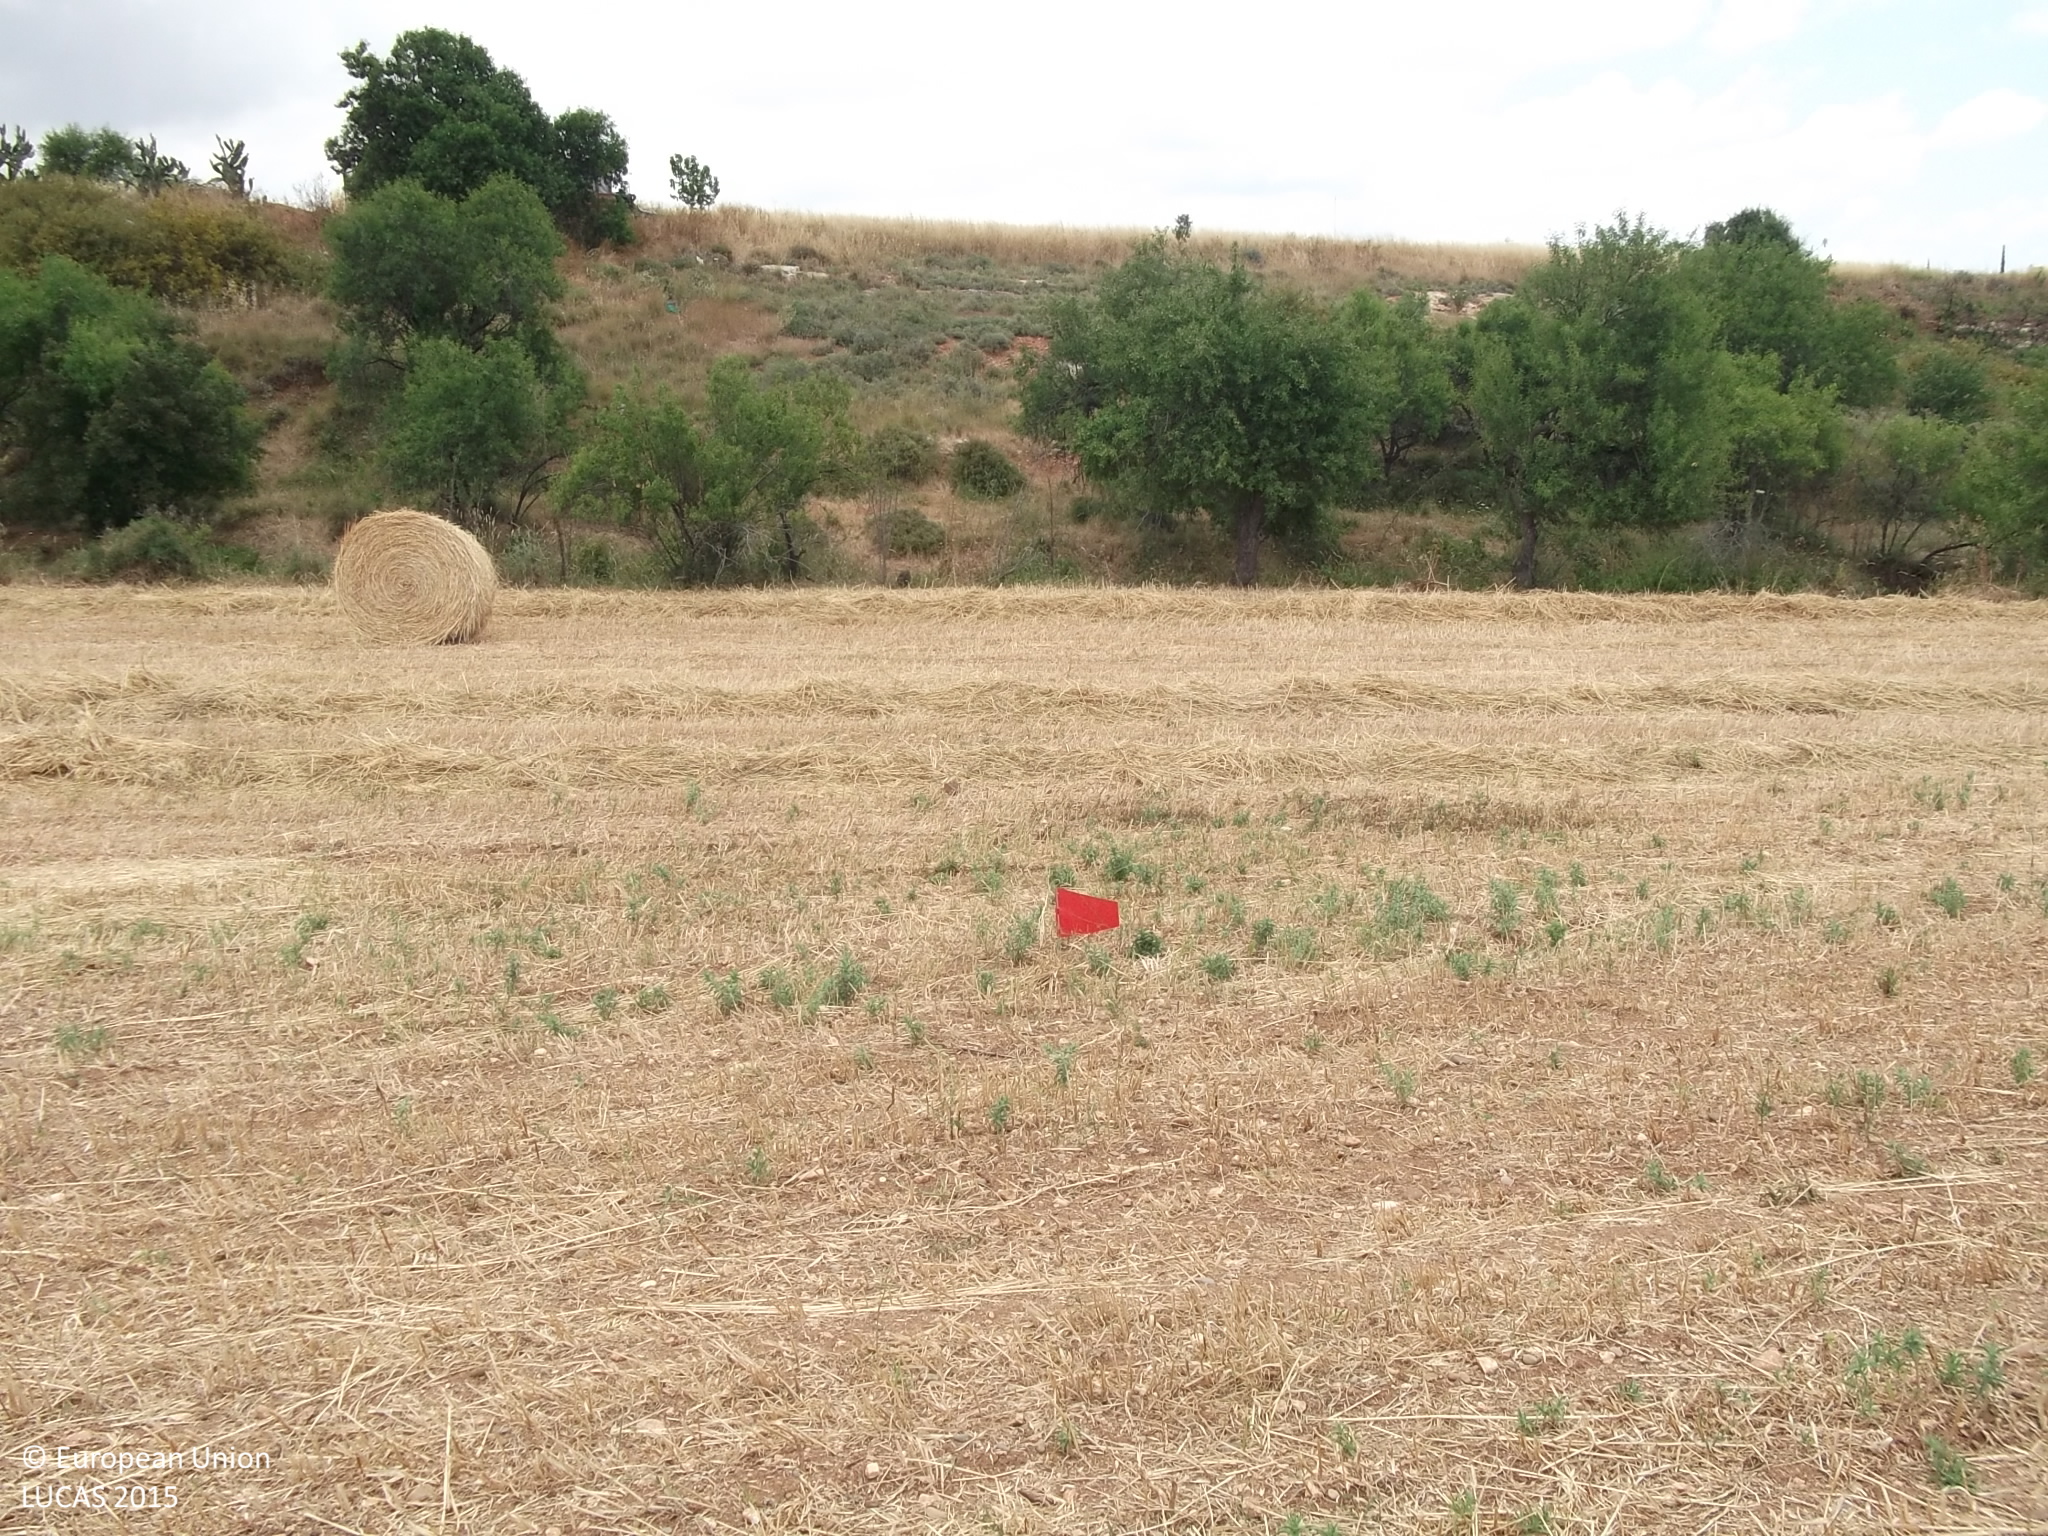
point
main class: Cropland
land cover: Mixed cereals for fodder
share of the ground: < 10 %
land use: Agriculture (excluding fallow land and kitchen gardens)
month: May
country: CY
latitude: 34.7446
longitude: 32.5286
